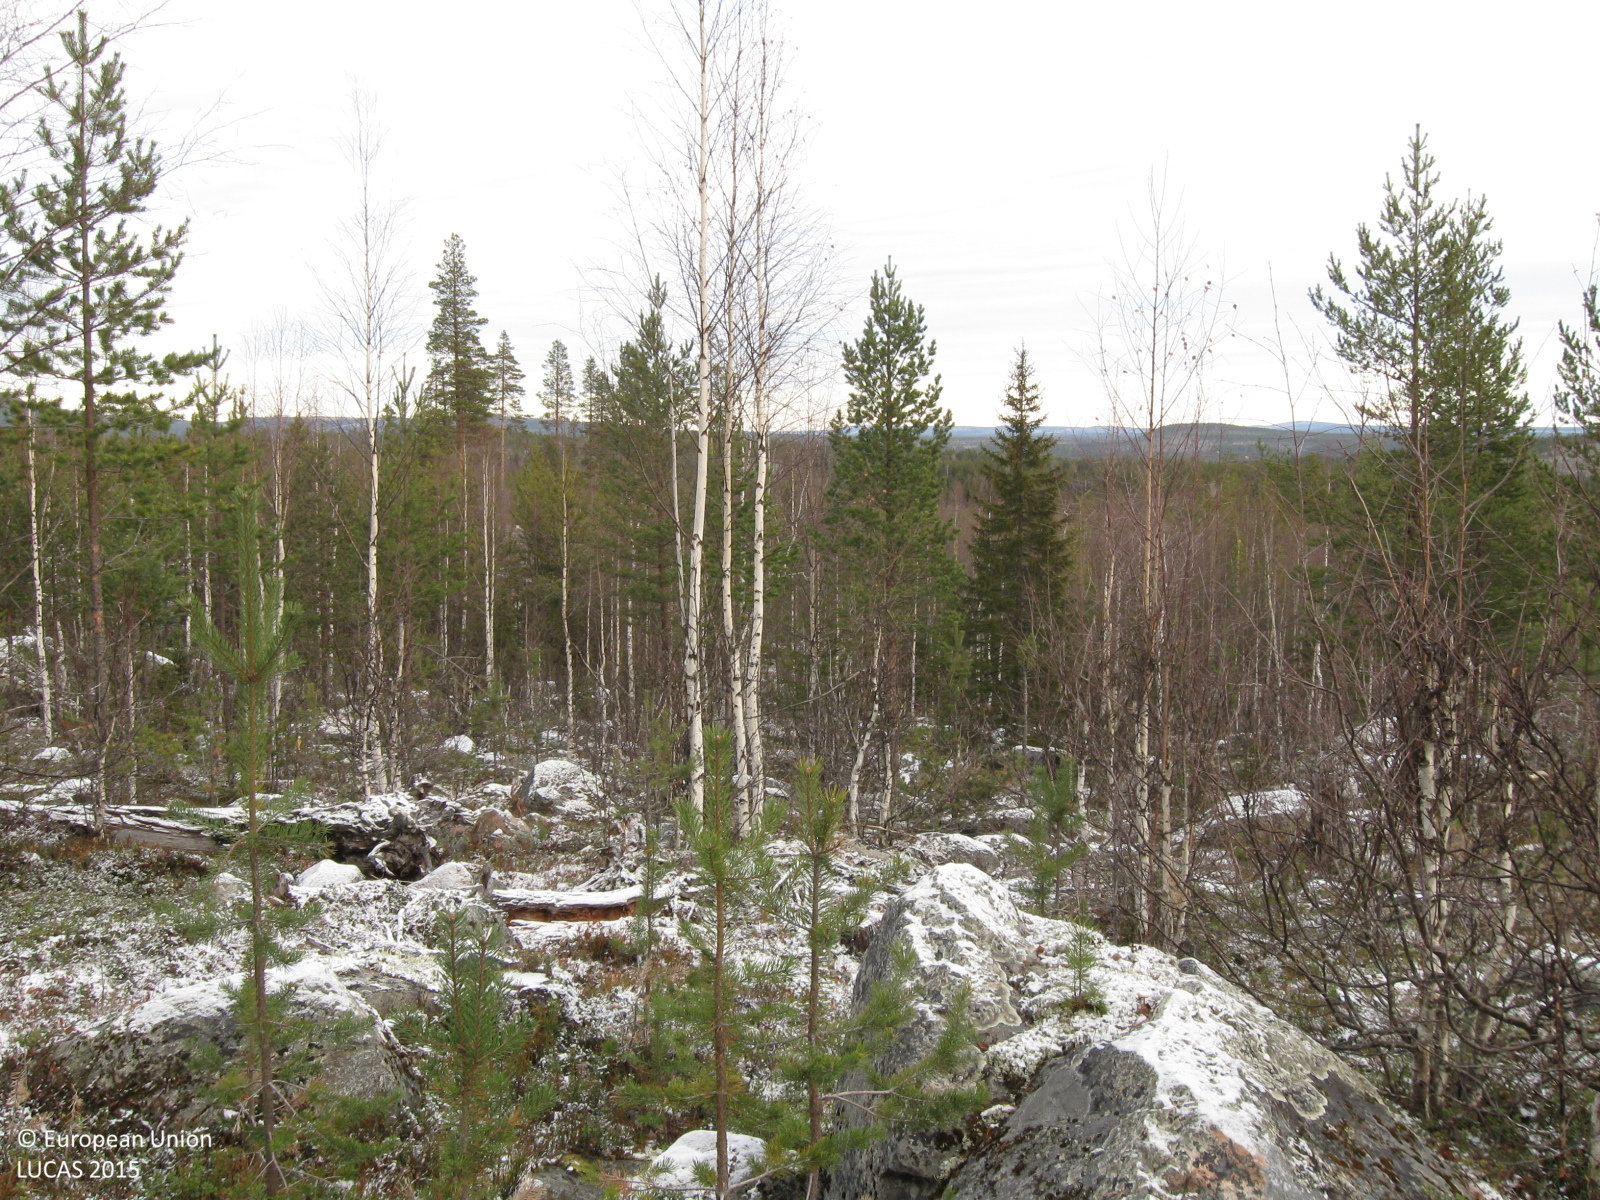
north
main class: Woodland
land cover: Pine dominated mixed woodland
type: boreal forest
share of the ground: 25 - 50 %
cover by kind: unconsolidated bare surface 35 %, coniferous forest trees 15 %, broadleaved forest trees 15 %, shrubs 15 %, herbaceous plants 10 %, lichens and mosses 10 %
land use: Forestry
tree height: < 5 m
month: October
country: SE
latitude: 66.2361
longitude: 21.6872
